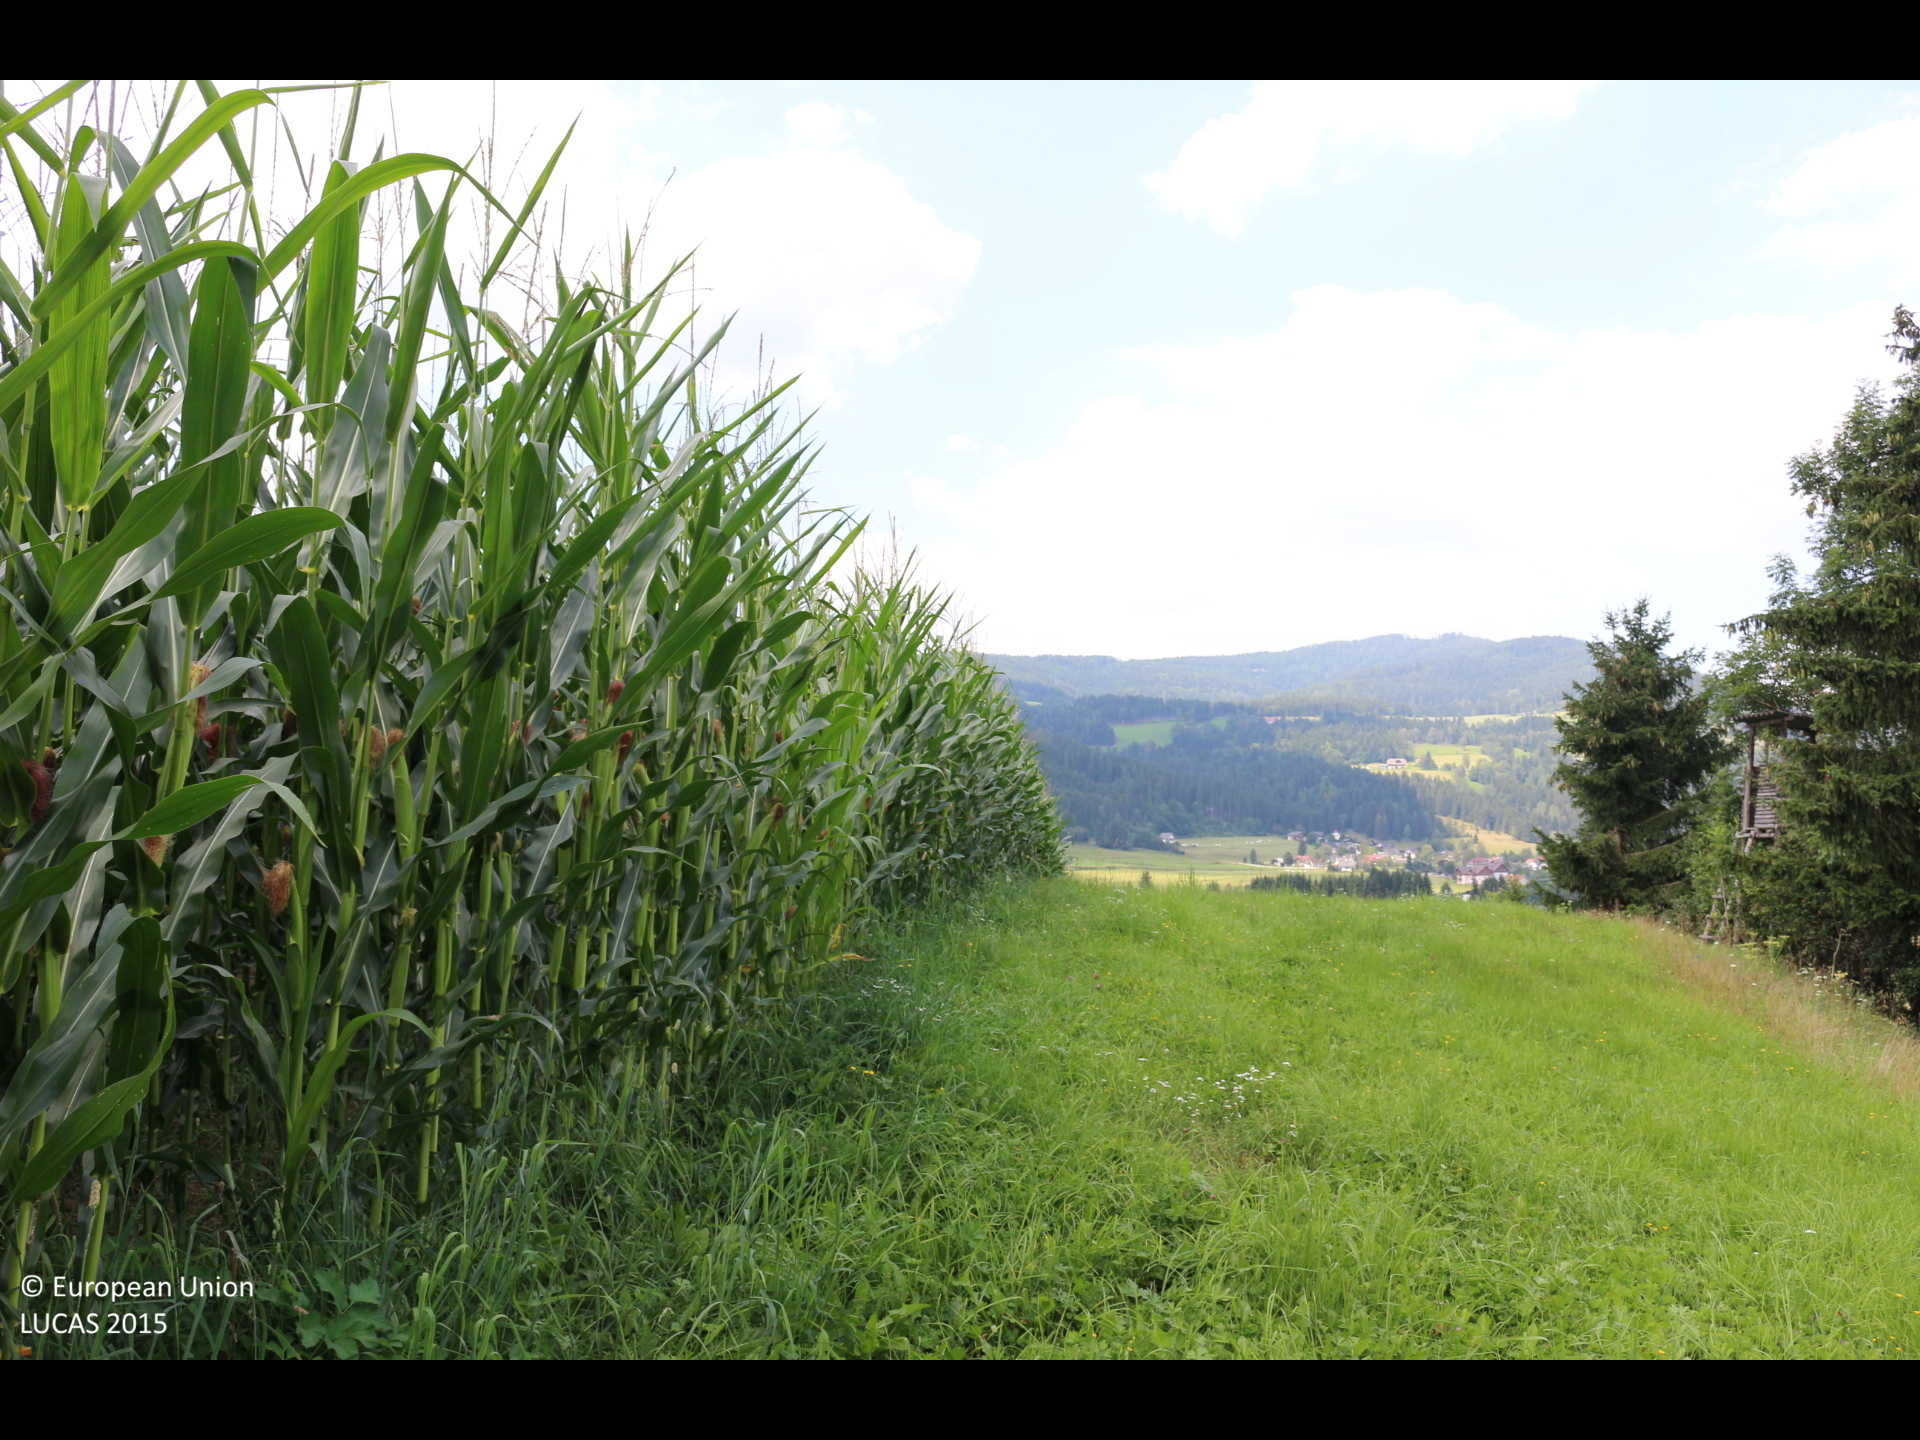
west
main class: Cropland
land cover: Maize
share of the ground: > 75 %
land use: Agriculture (excluding fallow land and kitchen gardens)
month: August
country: AT
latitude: 46.8665
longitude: 14.1301
